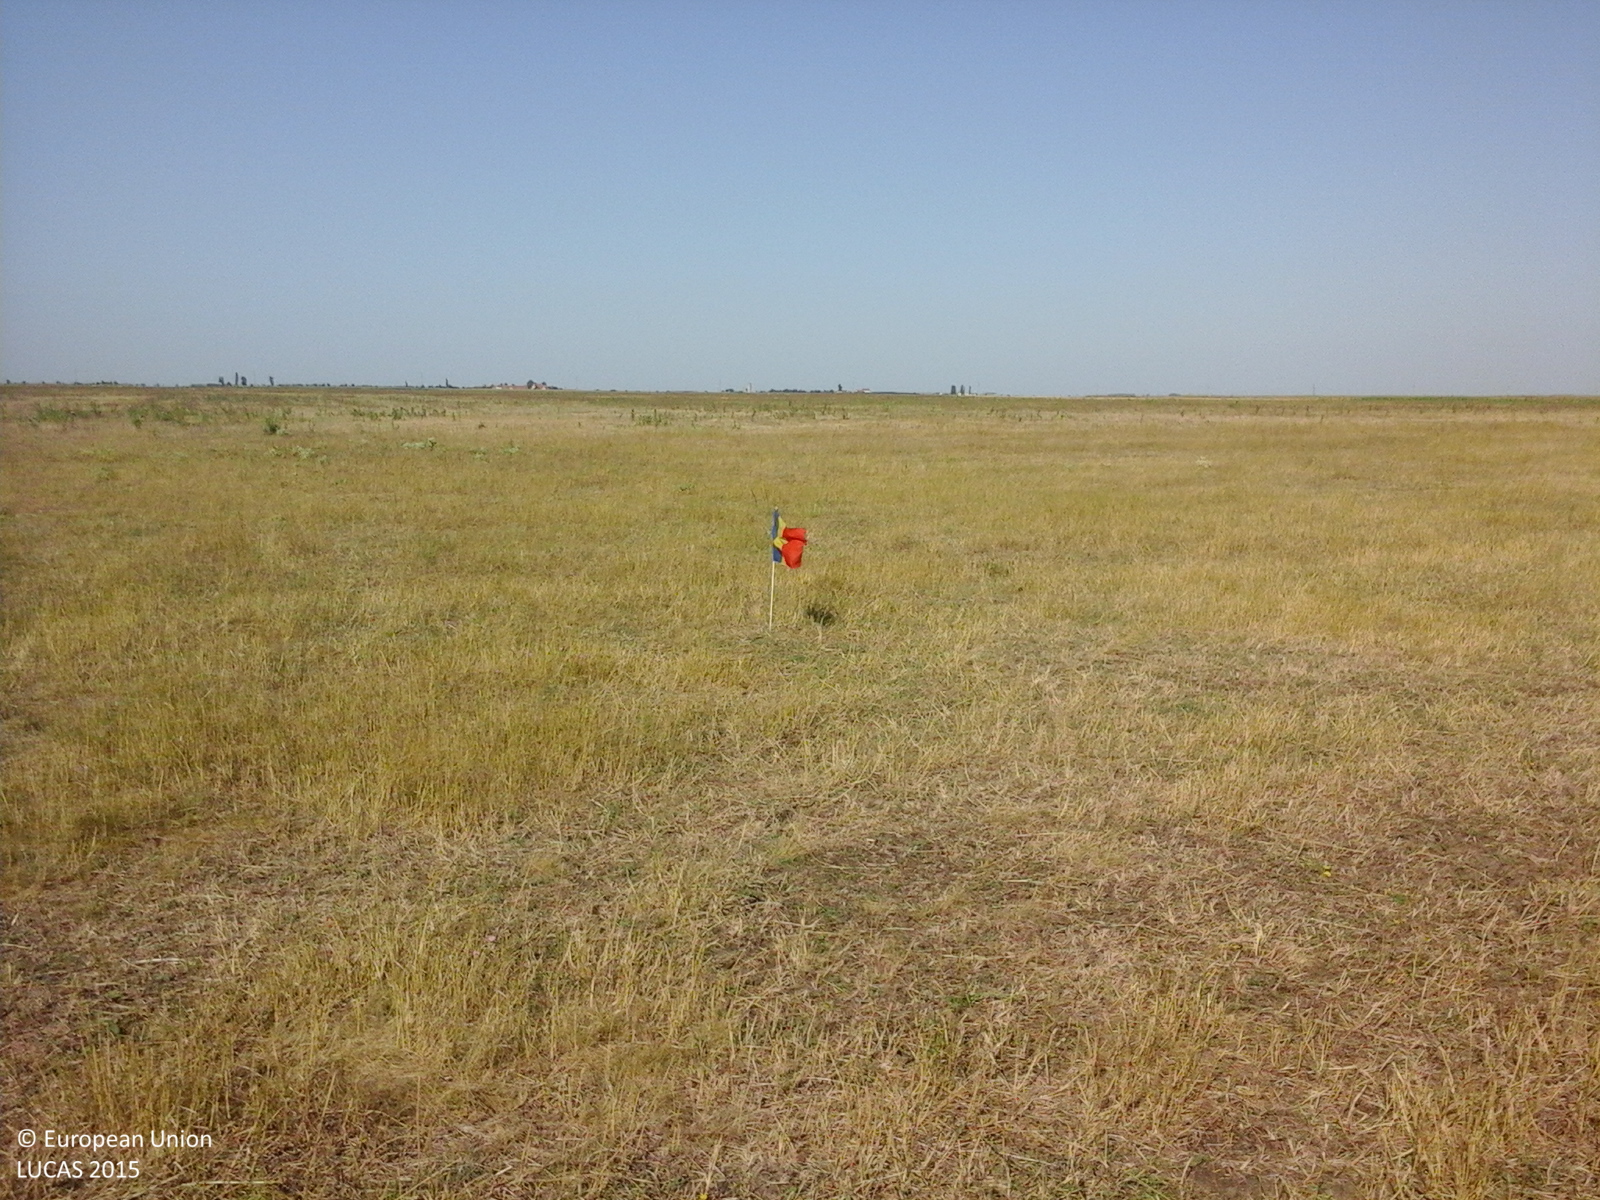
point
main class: Grassland
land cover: Grassland without tree/shrub cover
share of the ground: > 75 %
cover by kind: herbaceous plants 100 %
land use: Agriculture (excluding fallow land and kitchen gardens)
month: August
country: RO
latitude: 45.0349
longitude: 26.8739
